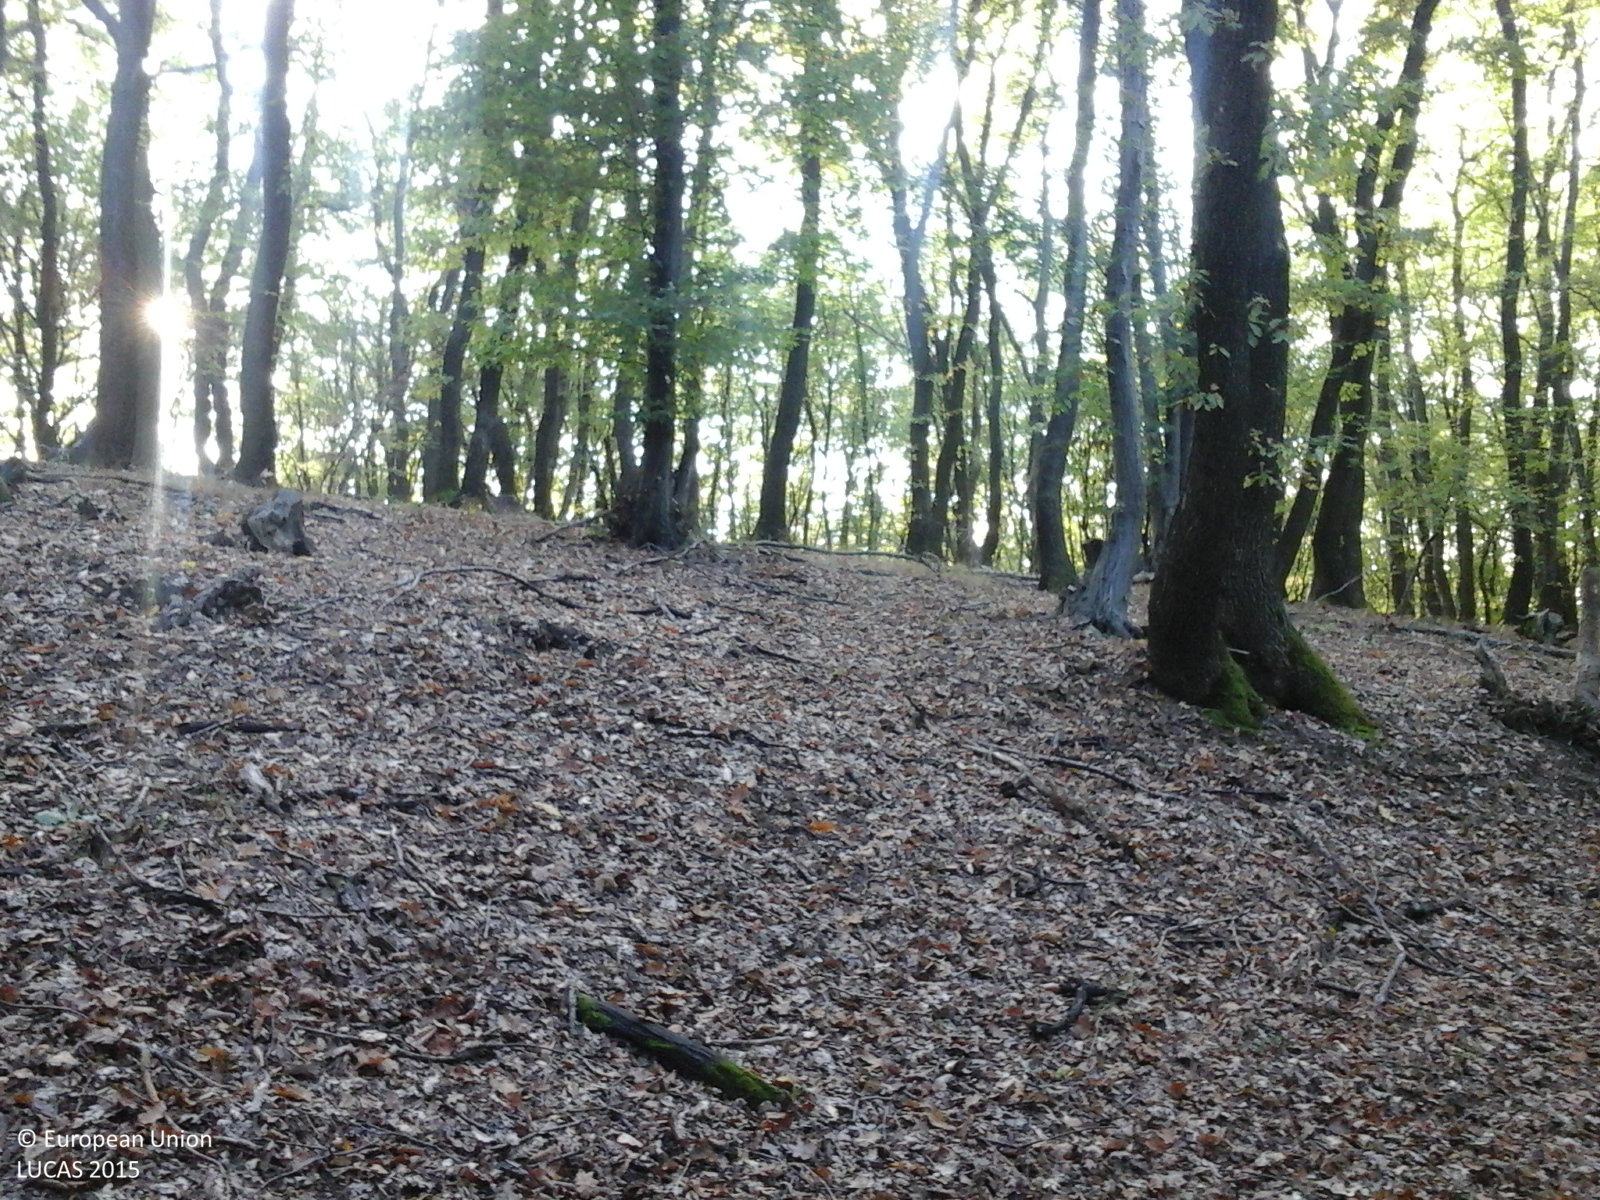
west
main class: Woodland
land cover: Broadleaved woodland
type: acidophilous oak and oak-birch forest
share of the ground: > 75 %
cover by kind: broadleaved forest trees 100 %
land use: Forestry
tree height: > 5 m
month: October
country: RO
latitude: 46.1821
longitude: 24.2127
